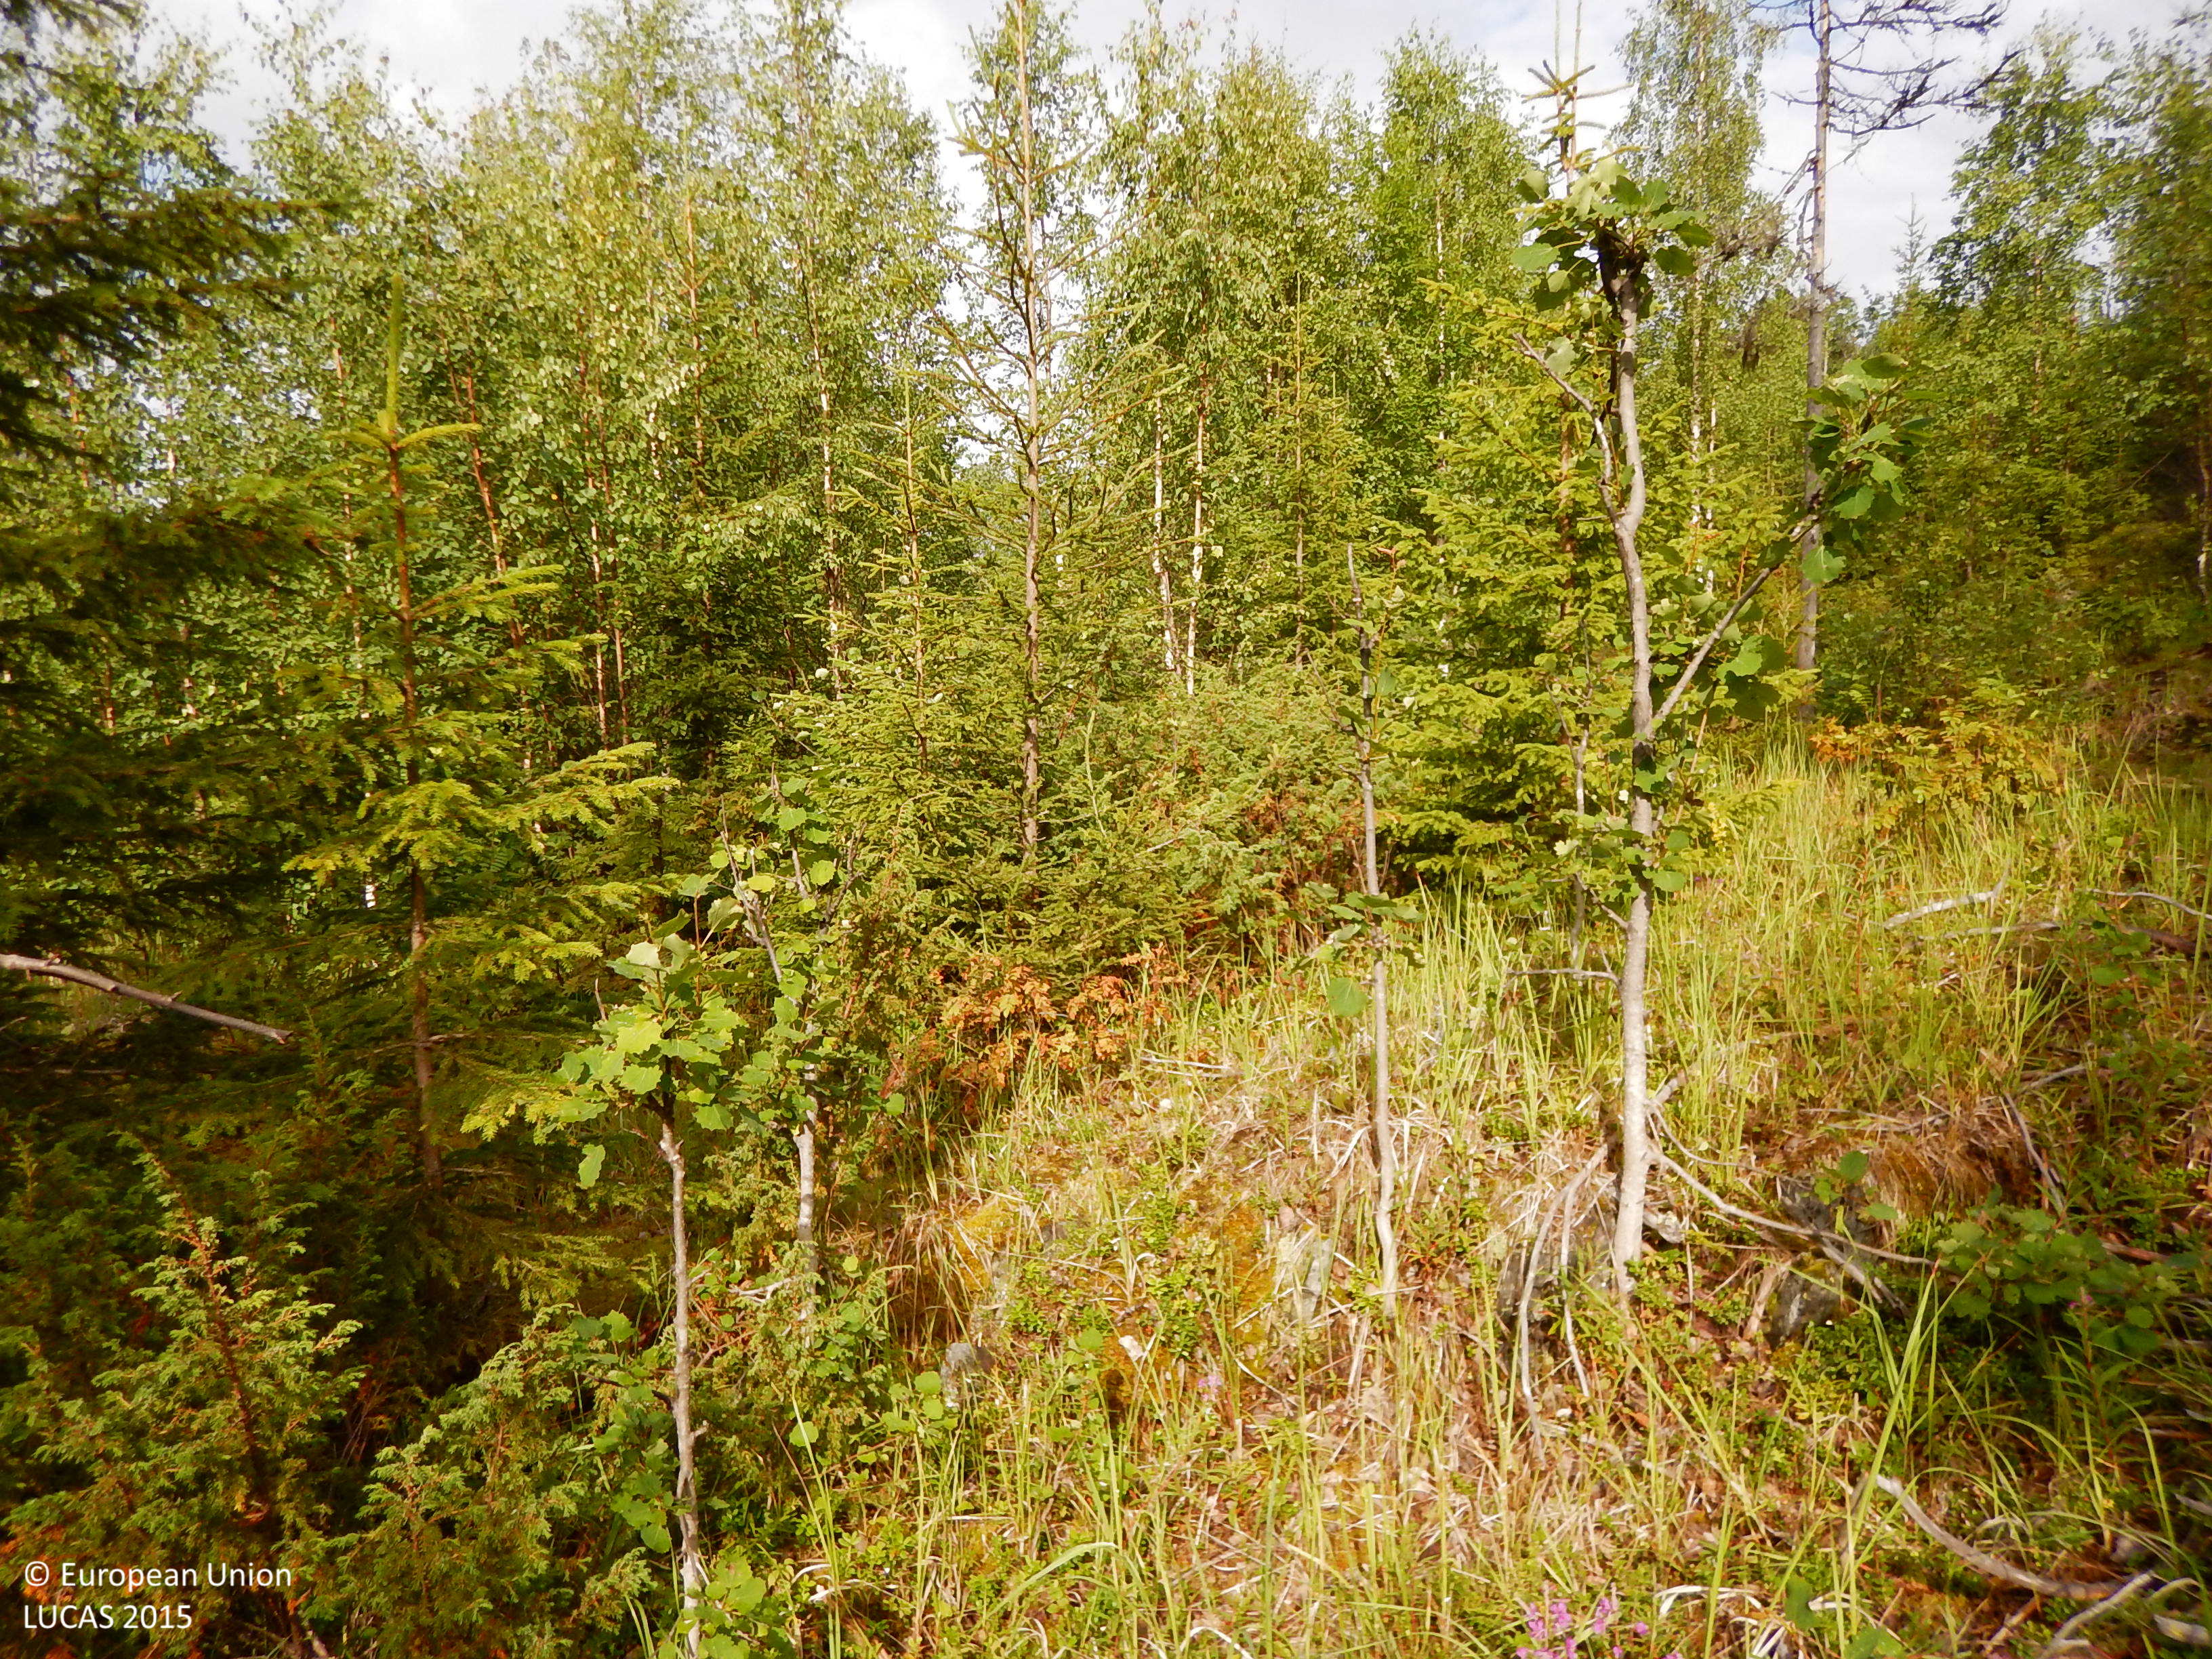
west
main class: Woodland
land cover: Broadleaved woodland
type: boreal forest
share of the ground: 50 - 75 %
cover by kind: broadleaved forest trees 50 %, shrubs 20 %, herbaceous plants 20 %, coniferous forest trees 10 %
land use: Forestry
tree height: > 5 m
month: July
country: SE
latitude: 64.8004
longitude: 20.7323
